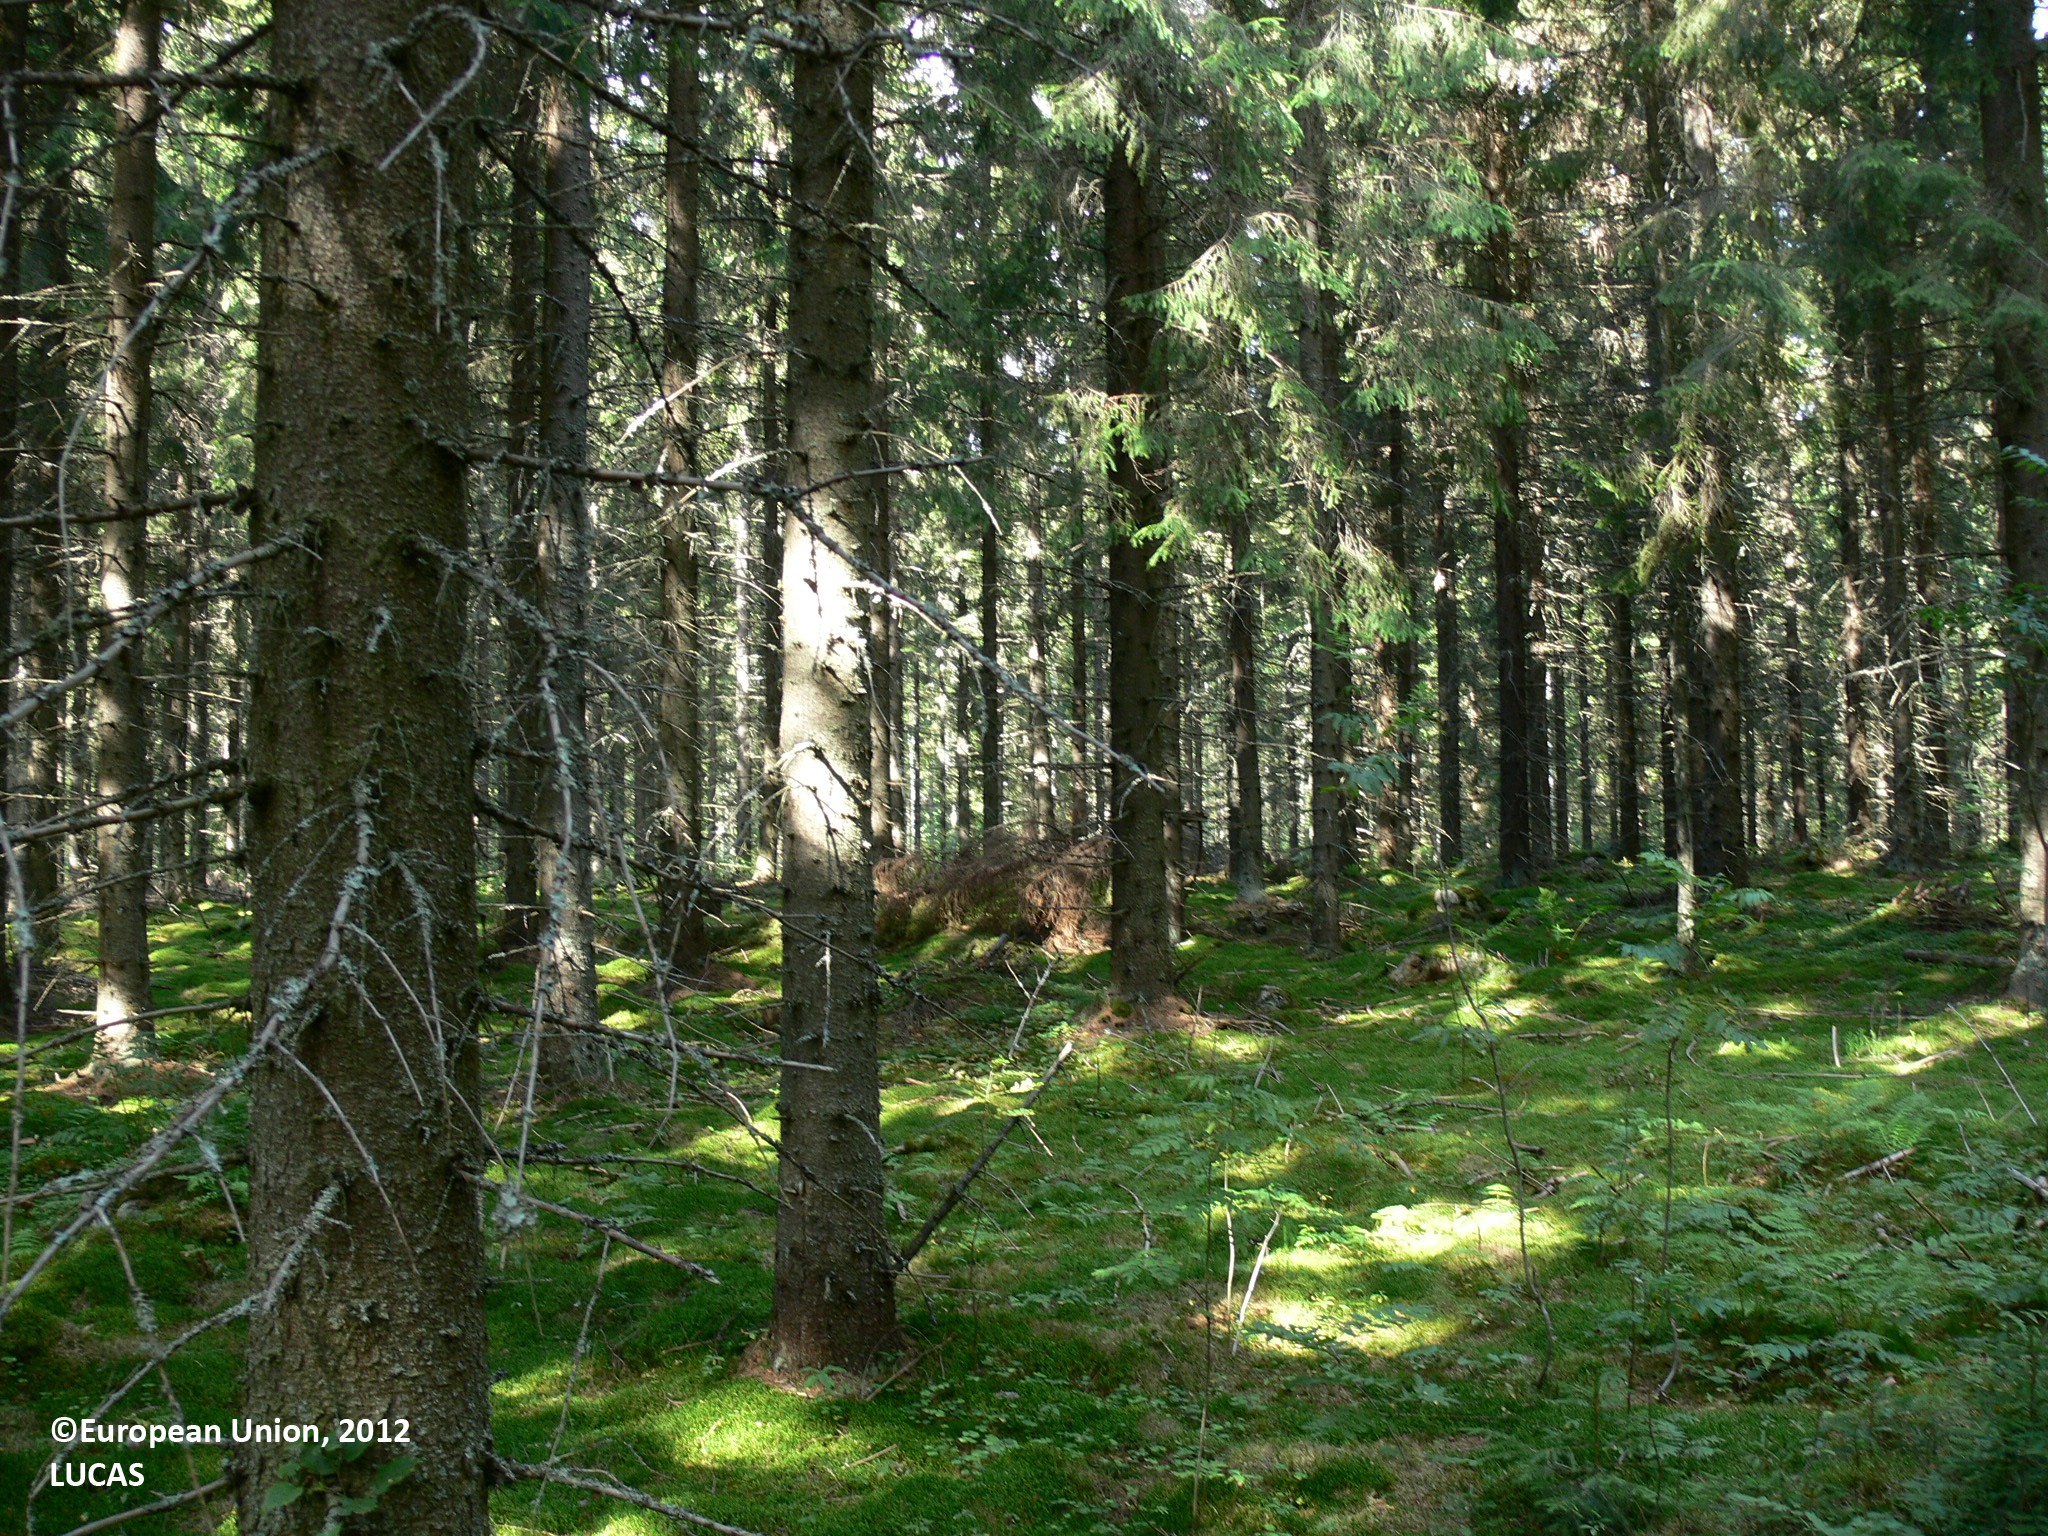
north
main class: Woodland
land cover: Spruce dominated coniferous woodland
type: boreal forest
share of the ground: > 75 %
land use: Forestry
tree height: > 5 m
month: August
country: FI
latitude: 62.0076
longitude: 29.3570
